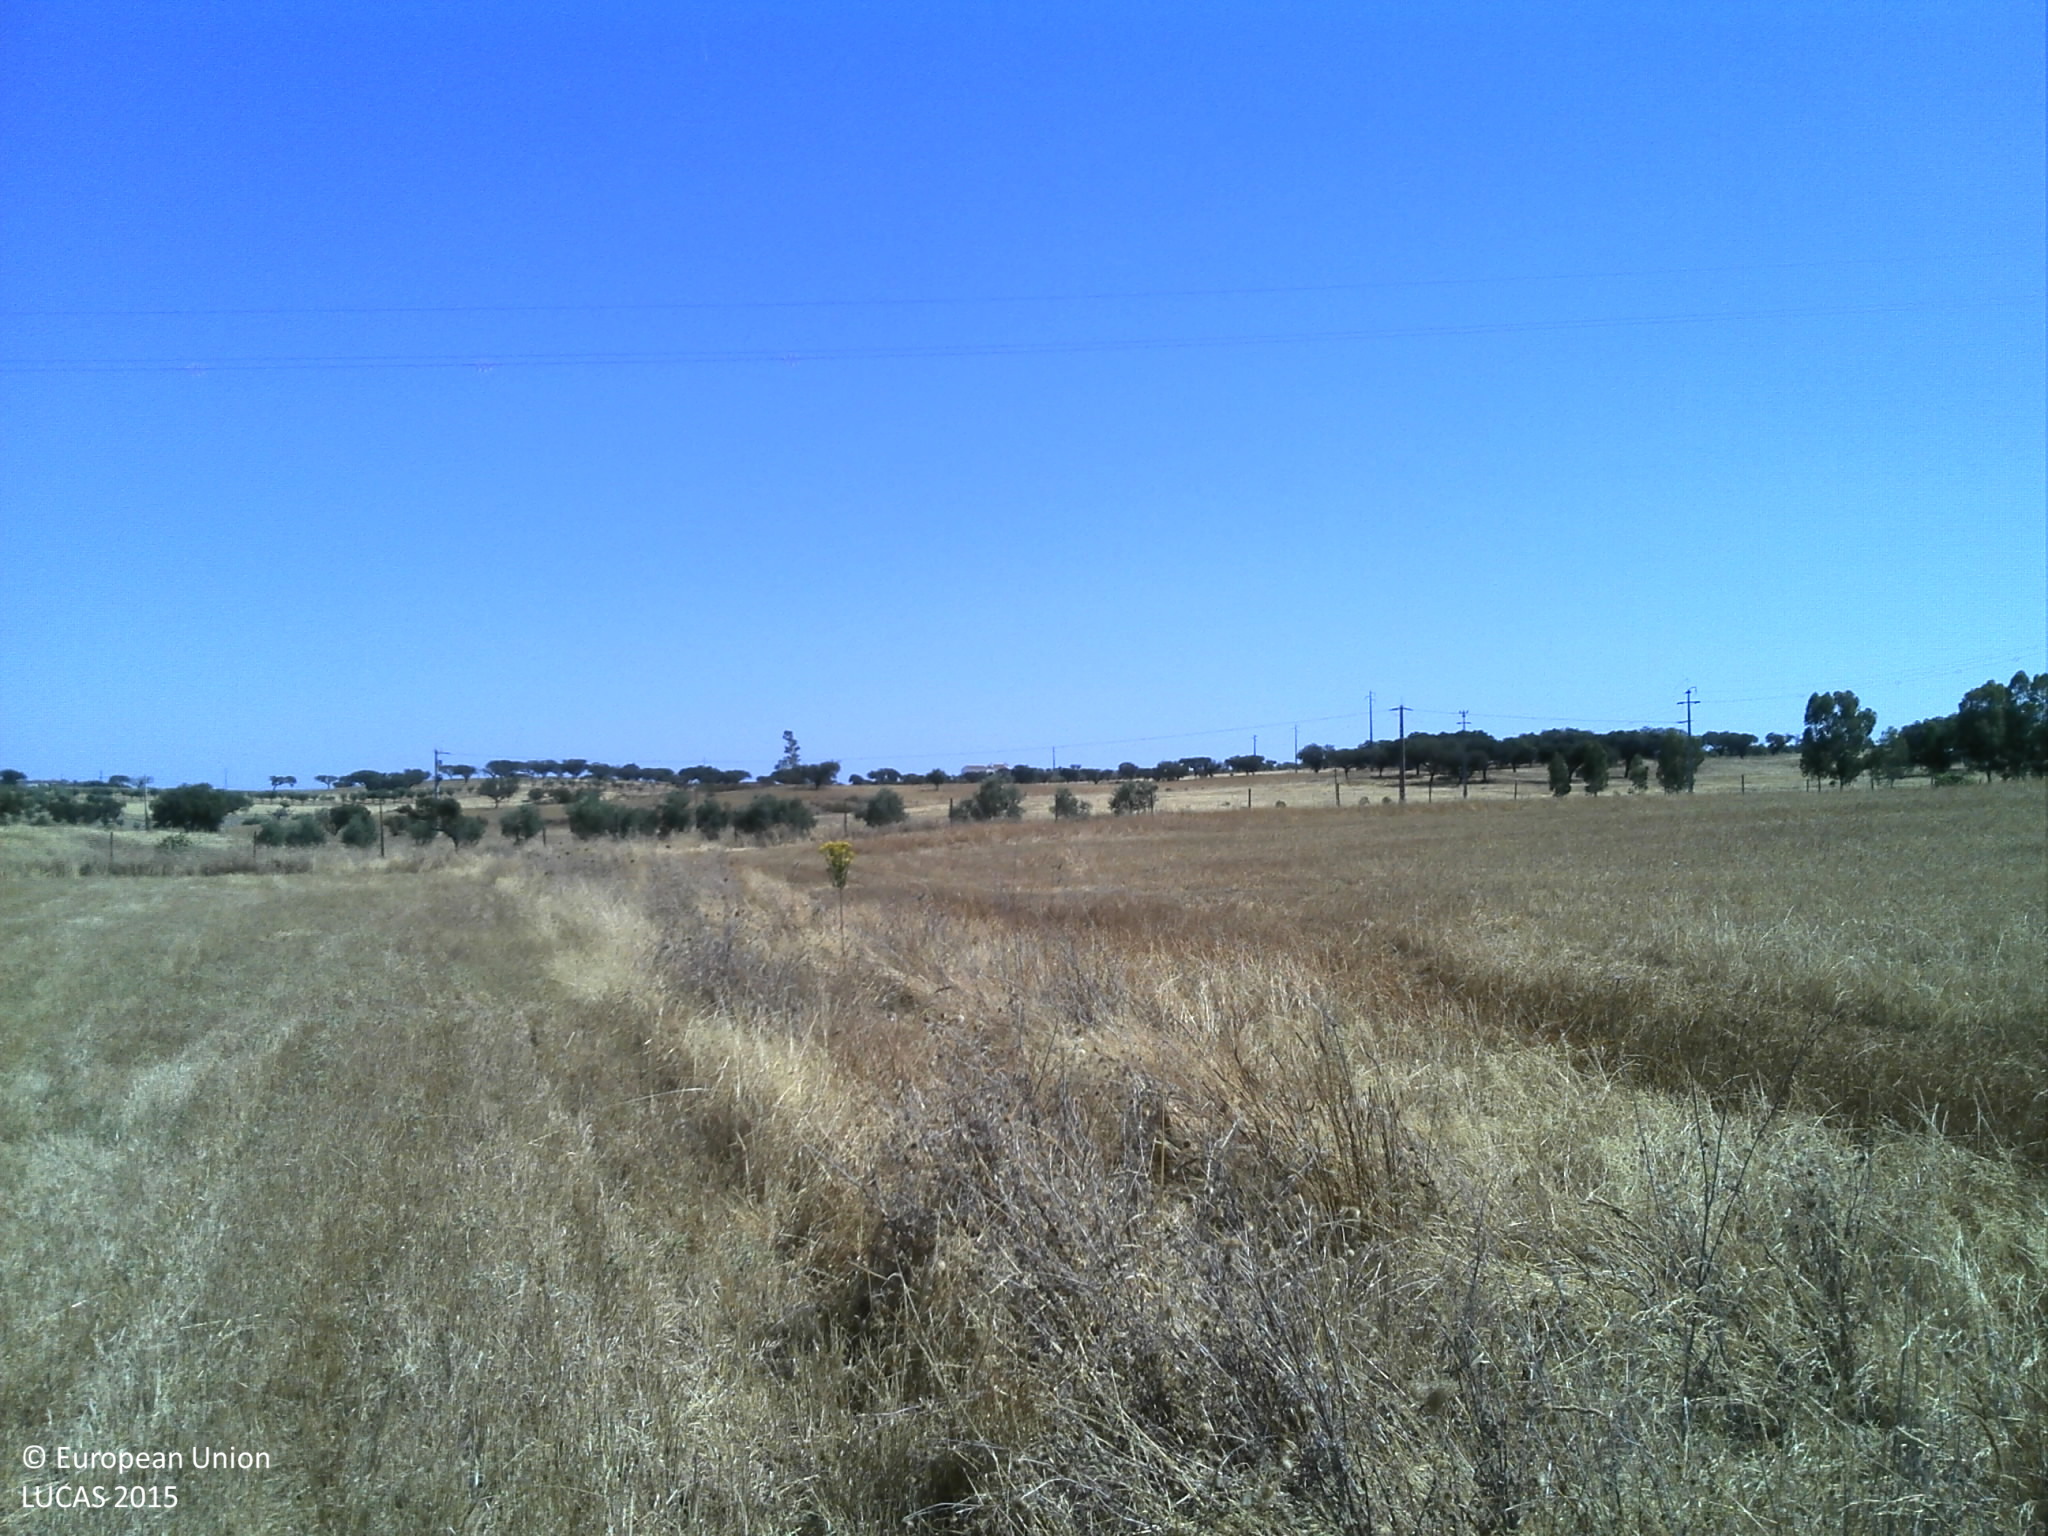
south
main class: Cropland
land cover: Oats
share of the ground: < 10 %
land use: Agriculture (excluding fallow land and kitchen gardens)
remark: Harvested field
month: July
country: PT
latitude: 38.5358
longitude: -7.3838
